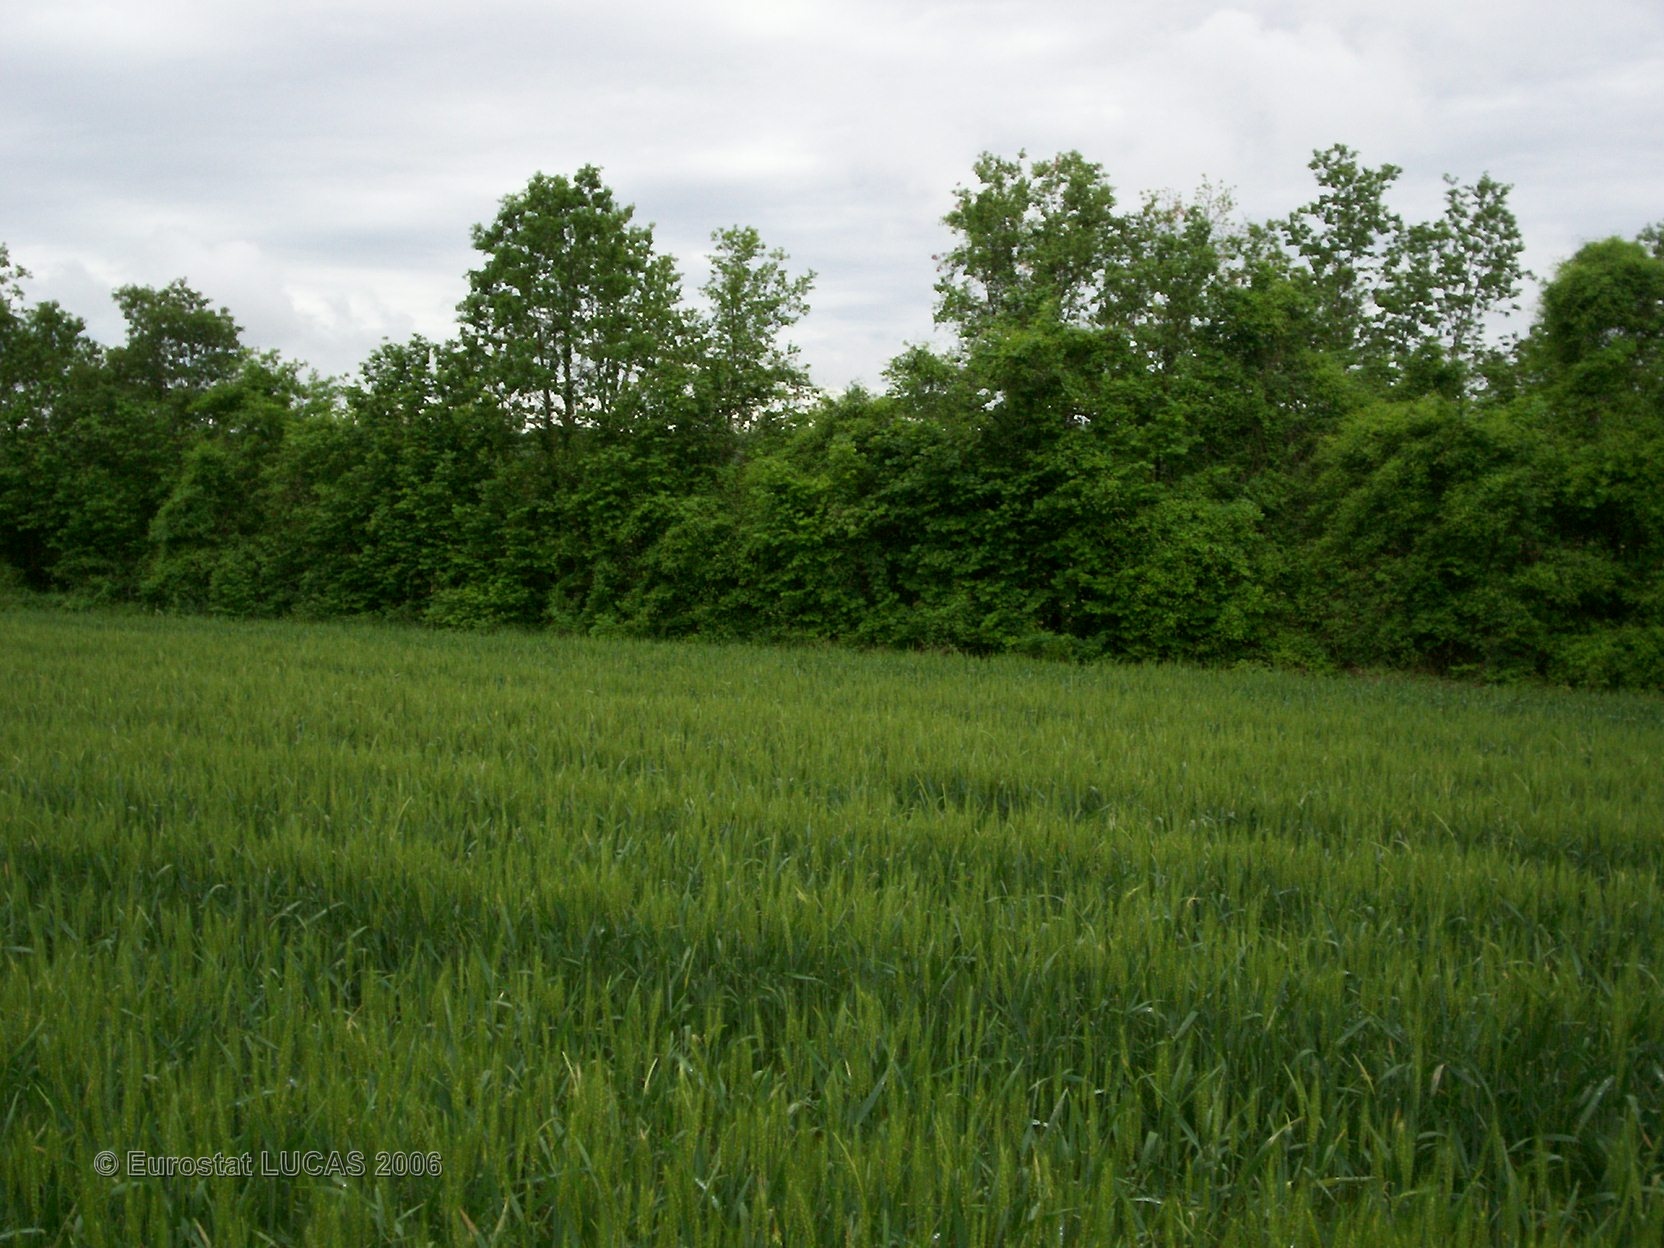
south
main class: Cropland
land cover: Triticale
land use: Agriculture (excluding fallow land and kitchen gardens)
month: May
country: FR
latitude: 45.3879
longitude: 0.5492
